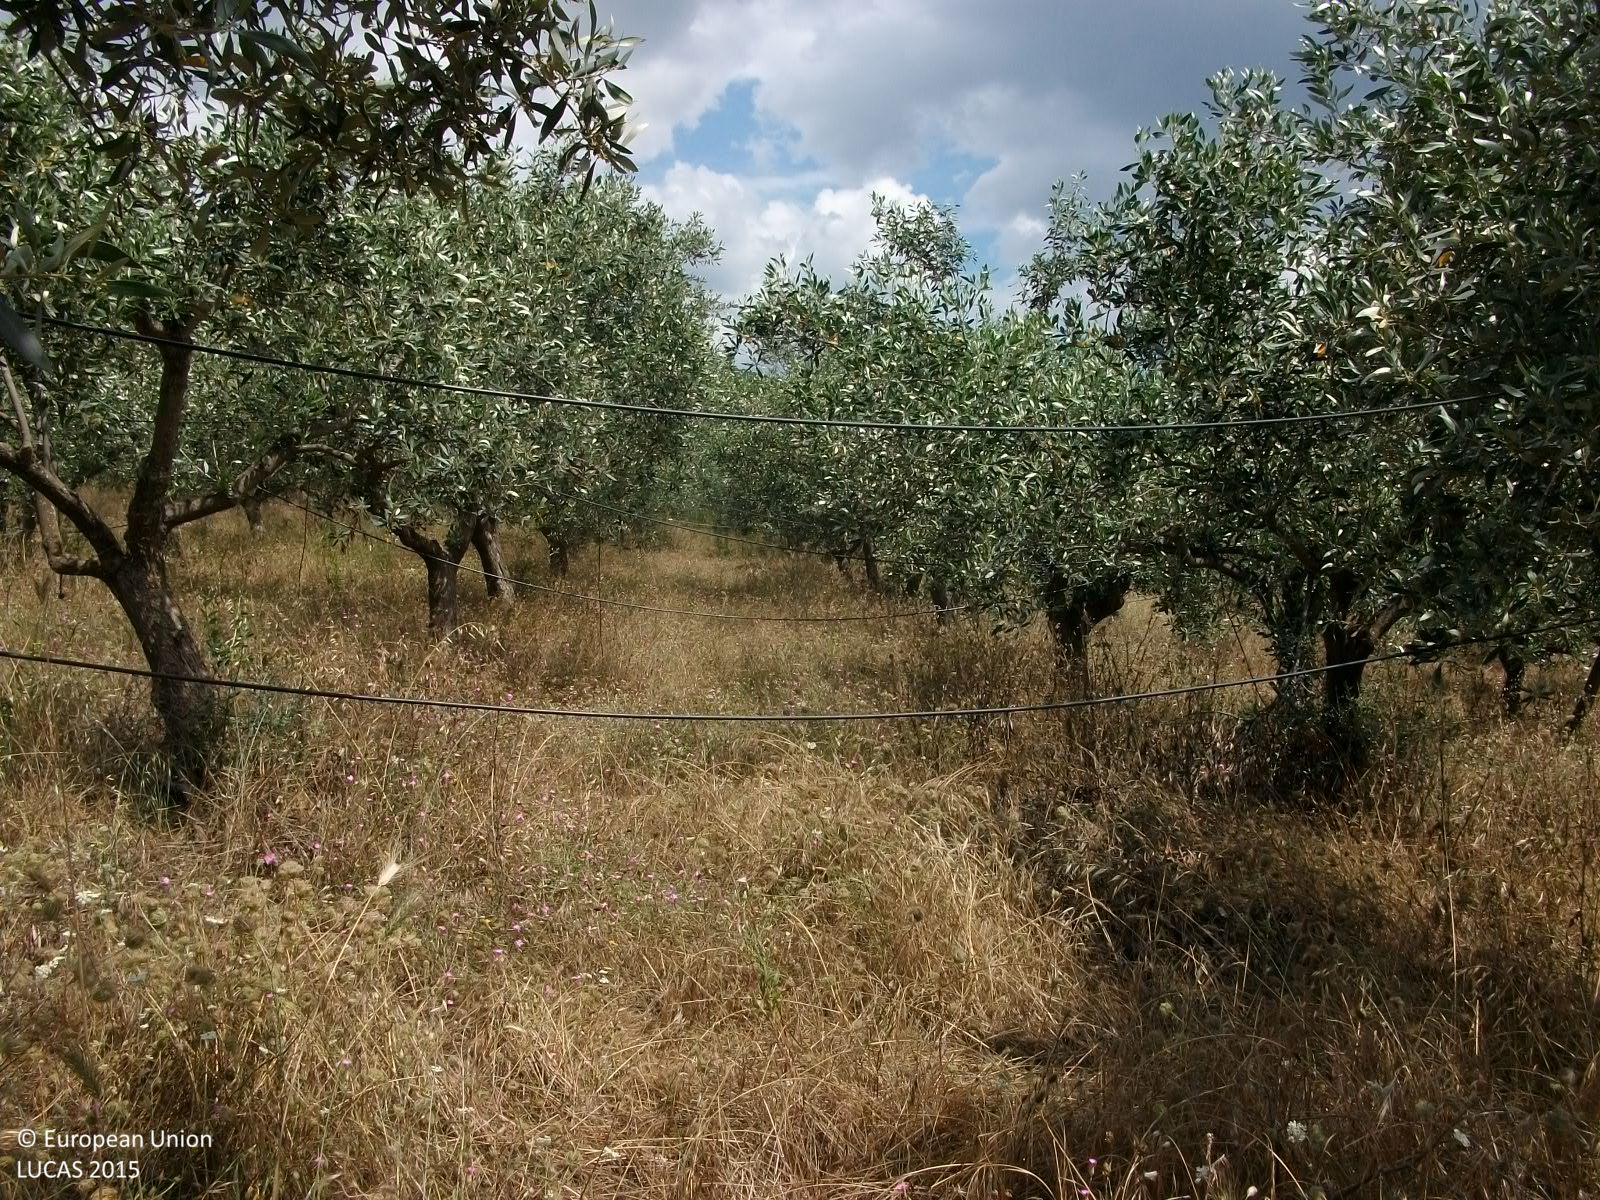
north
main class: Cropland
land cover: Olive groves
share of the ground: 50 - 75 %
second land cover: Spontaneously vegetated surfaces
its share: > 75 %
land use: Agriculture (excluding fallow land and kitchen gardens)
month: June
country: GR
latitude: 37.1647
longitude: 22.4462
